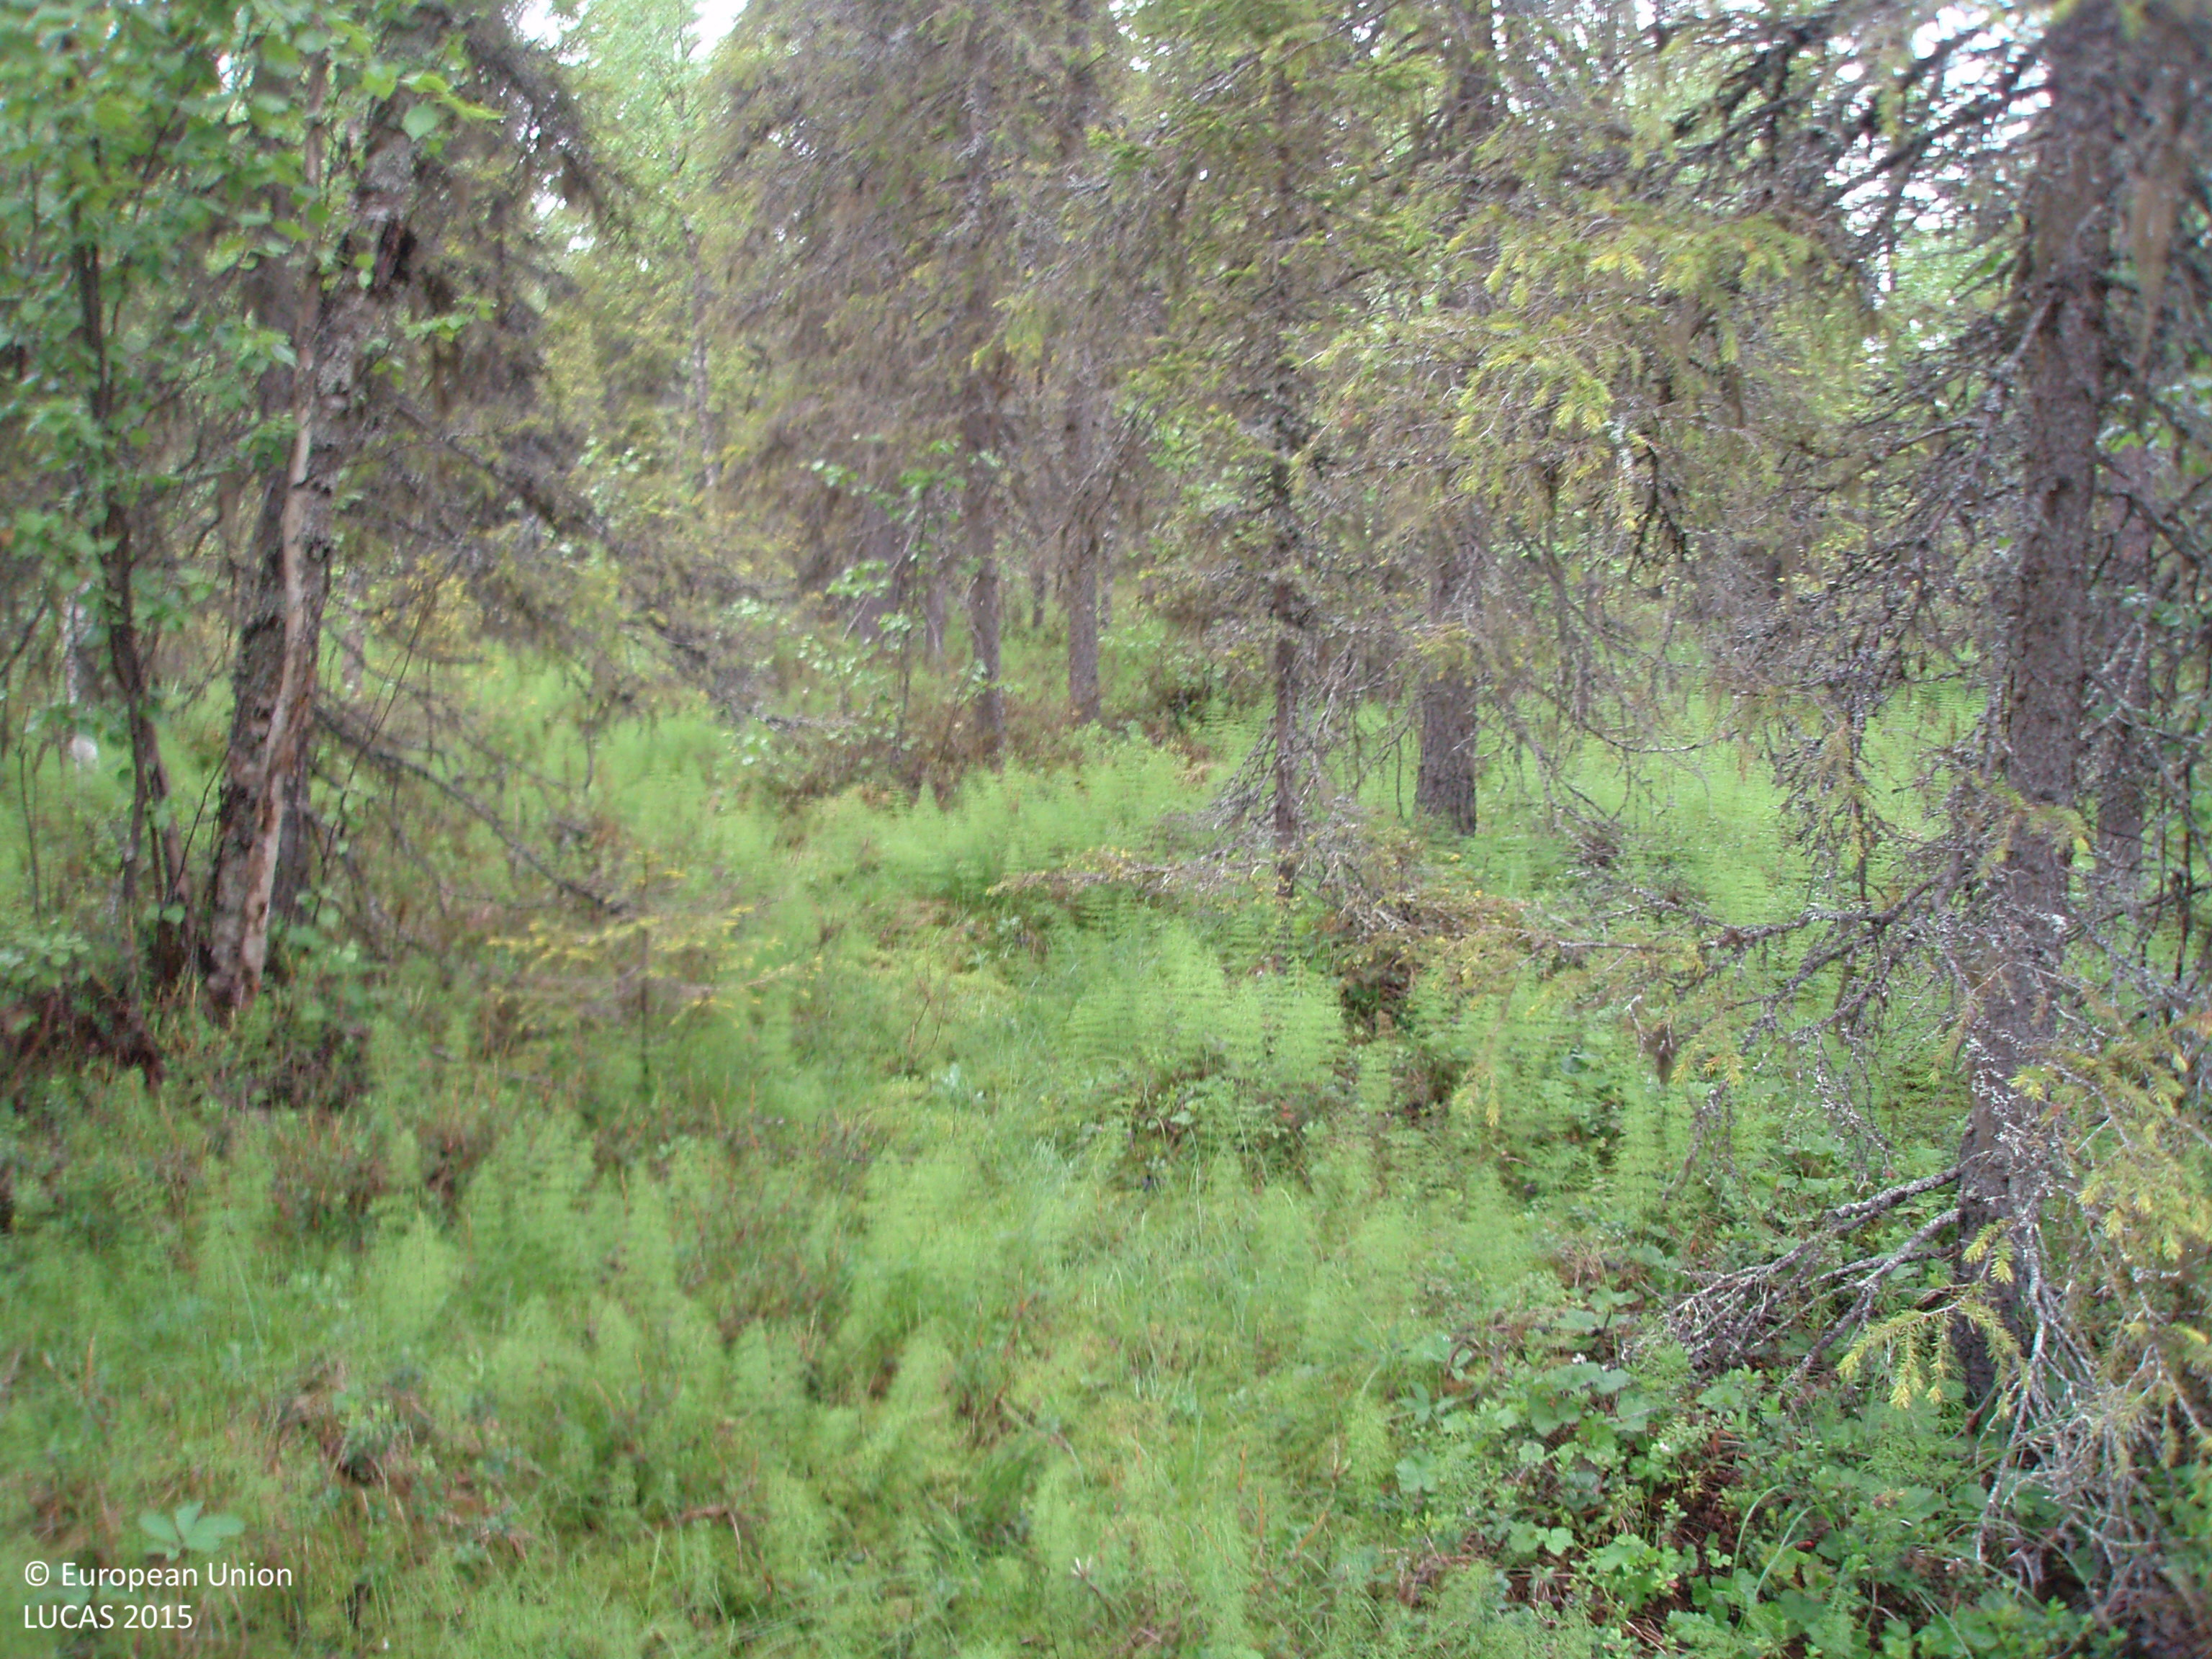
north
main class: Woodland
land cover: Spruce dominated mixed woodland
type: boreal forest
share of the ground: 50 - 75 %
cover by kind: coniferous forest trees 40 %, broadleaved forest trees 20 %, shrubs 20 %, herbaceous plants 20 %
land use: Forestry
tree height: > 5 m
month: July
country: FI
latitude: 67.2714
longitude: 28.2381
